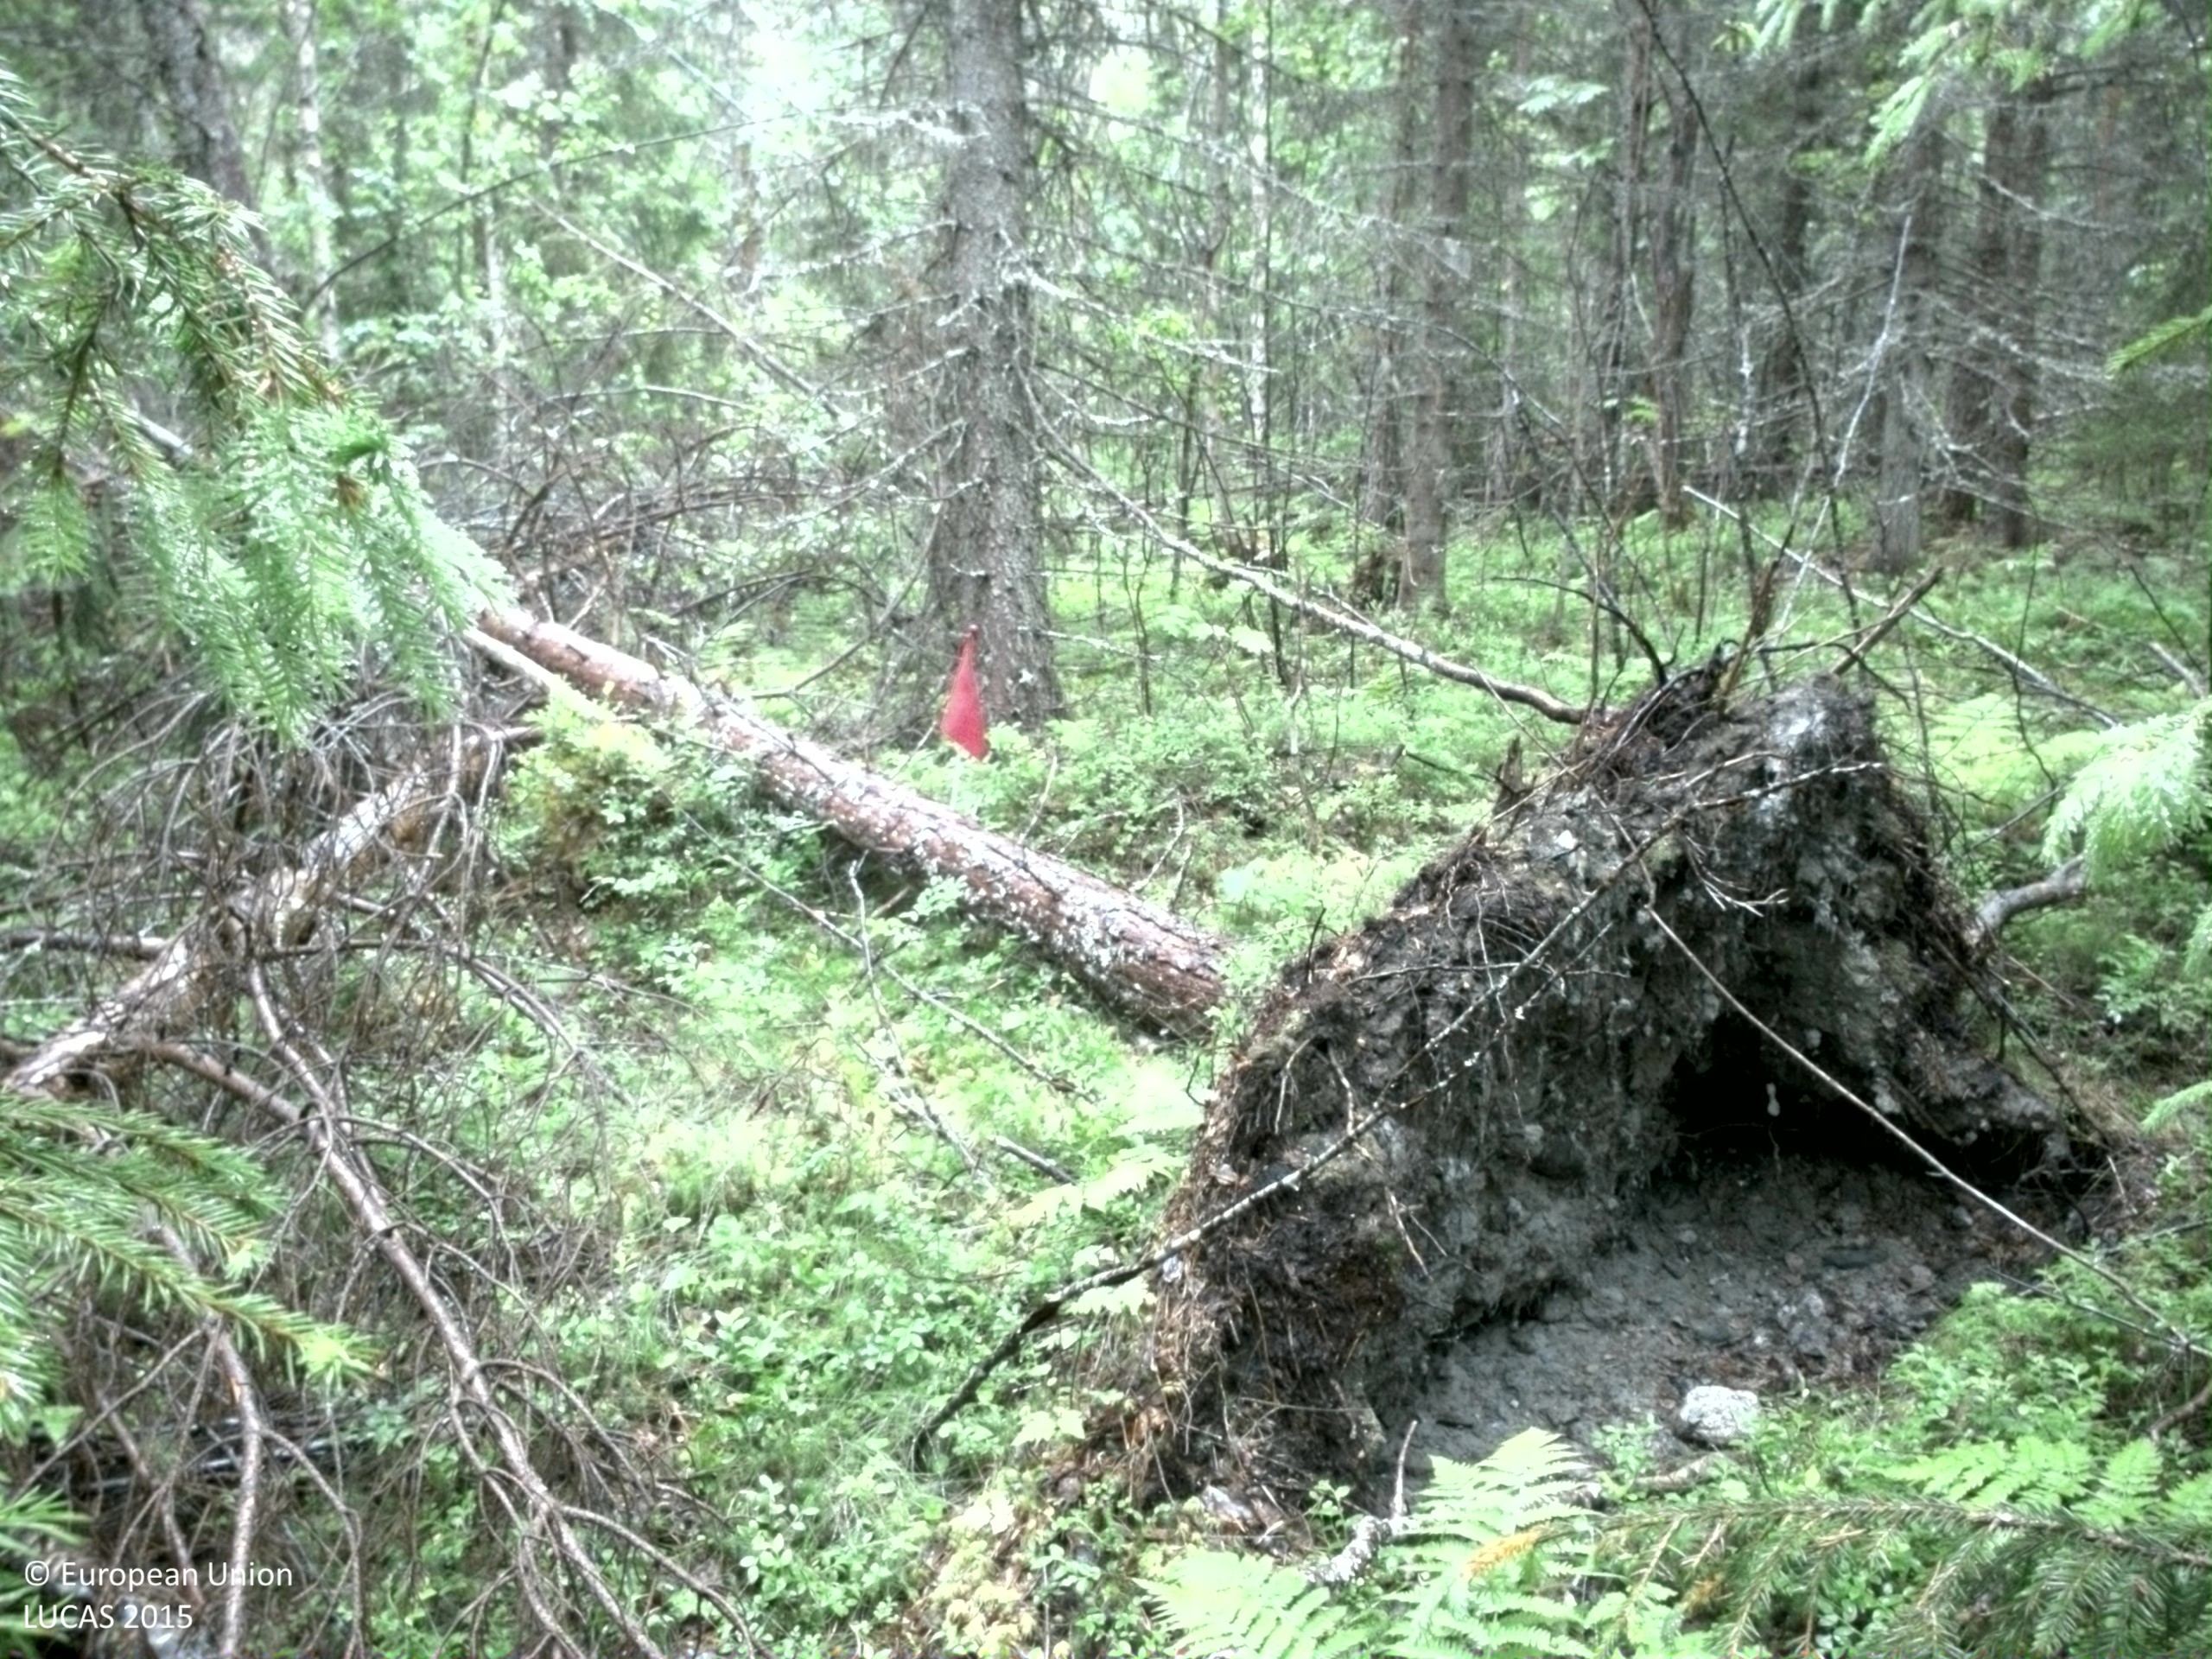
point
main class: Woodland
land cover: Spruce dominated mixed woodland
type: boreal forest
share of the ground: 50 - 75 %
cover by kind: coniferous forest trees 45 %, broadleaved forest trees 15 %, shrubs 15 %, herbaceous plants 15 %
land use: Forestry
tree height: > 5 m
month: July
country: SE
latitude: 63.1477
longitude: 17.1792
